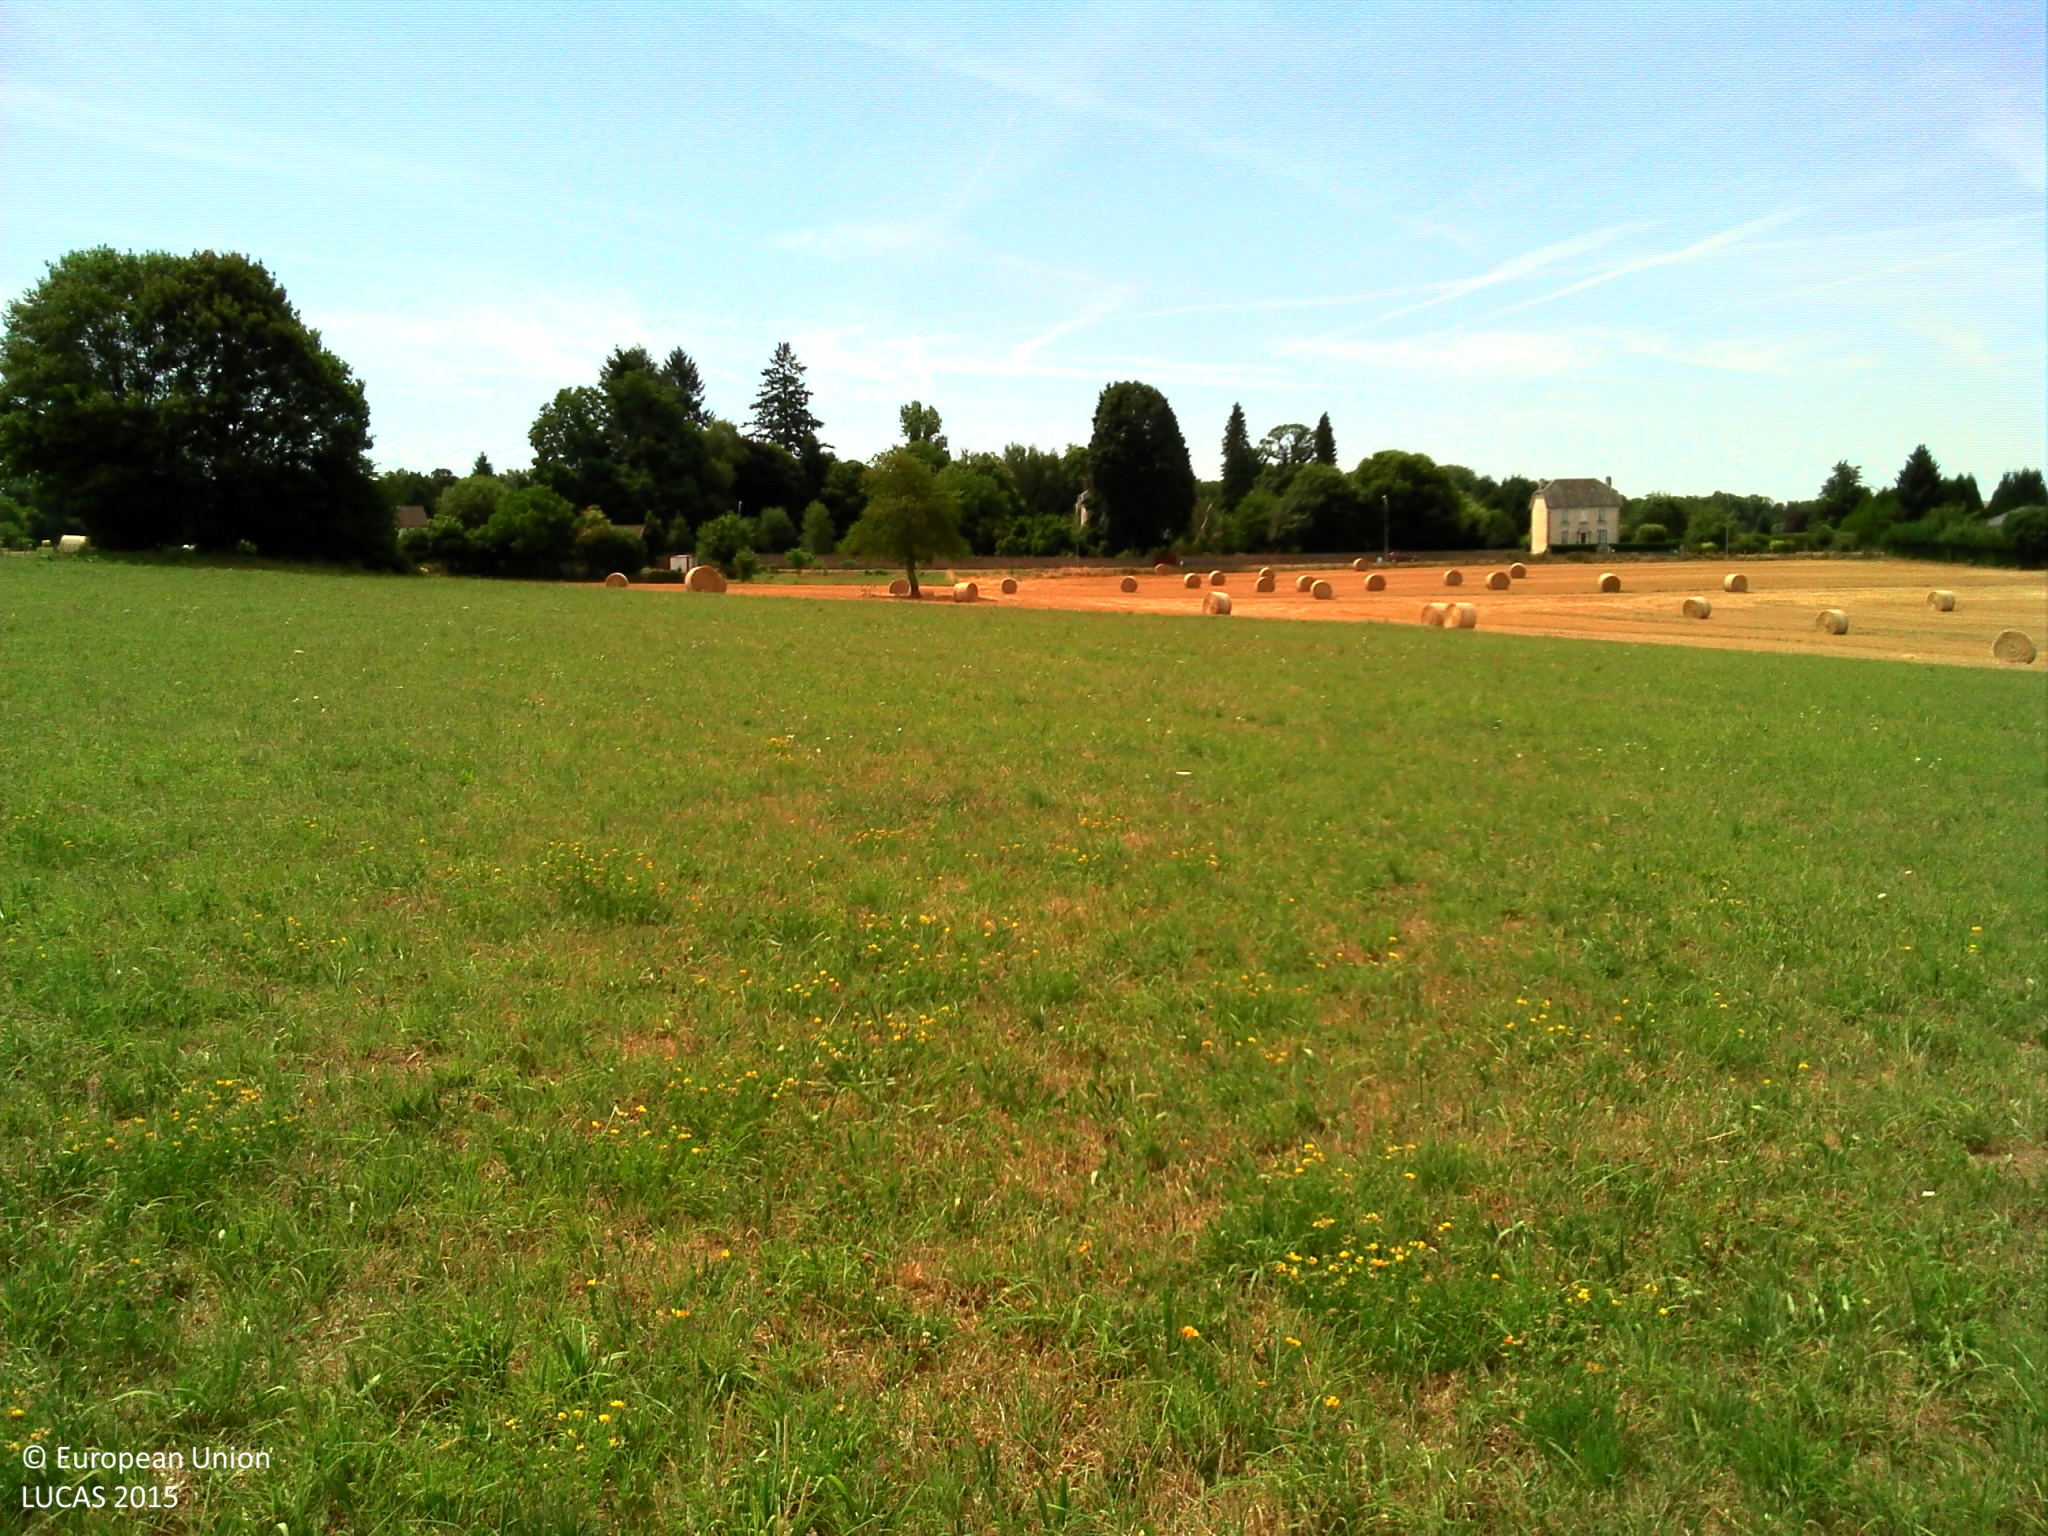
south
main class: Cropland
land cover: Temporary grasslands
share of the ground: > 75 %
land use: Agriculture (excluding fallow land and kitchen gardens)
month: July
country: FR
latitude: 45.7328
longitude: 1.6276
